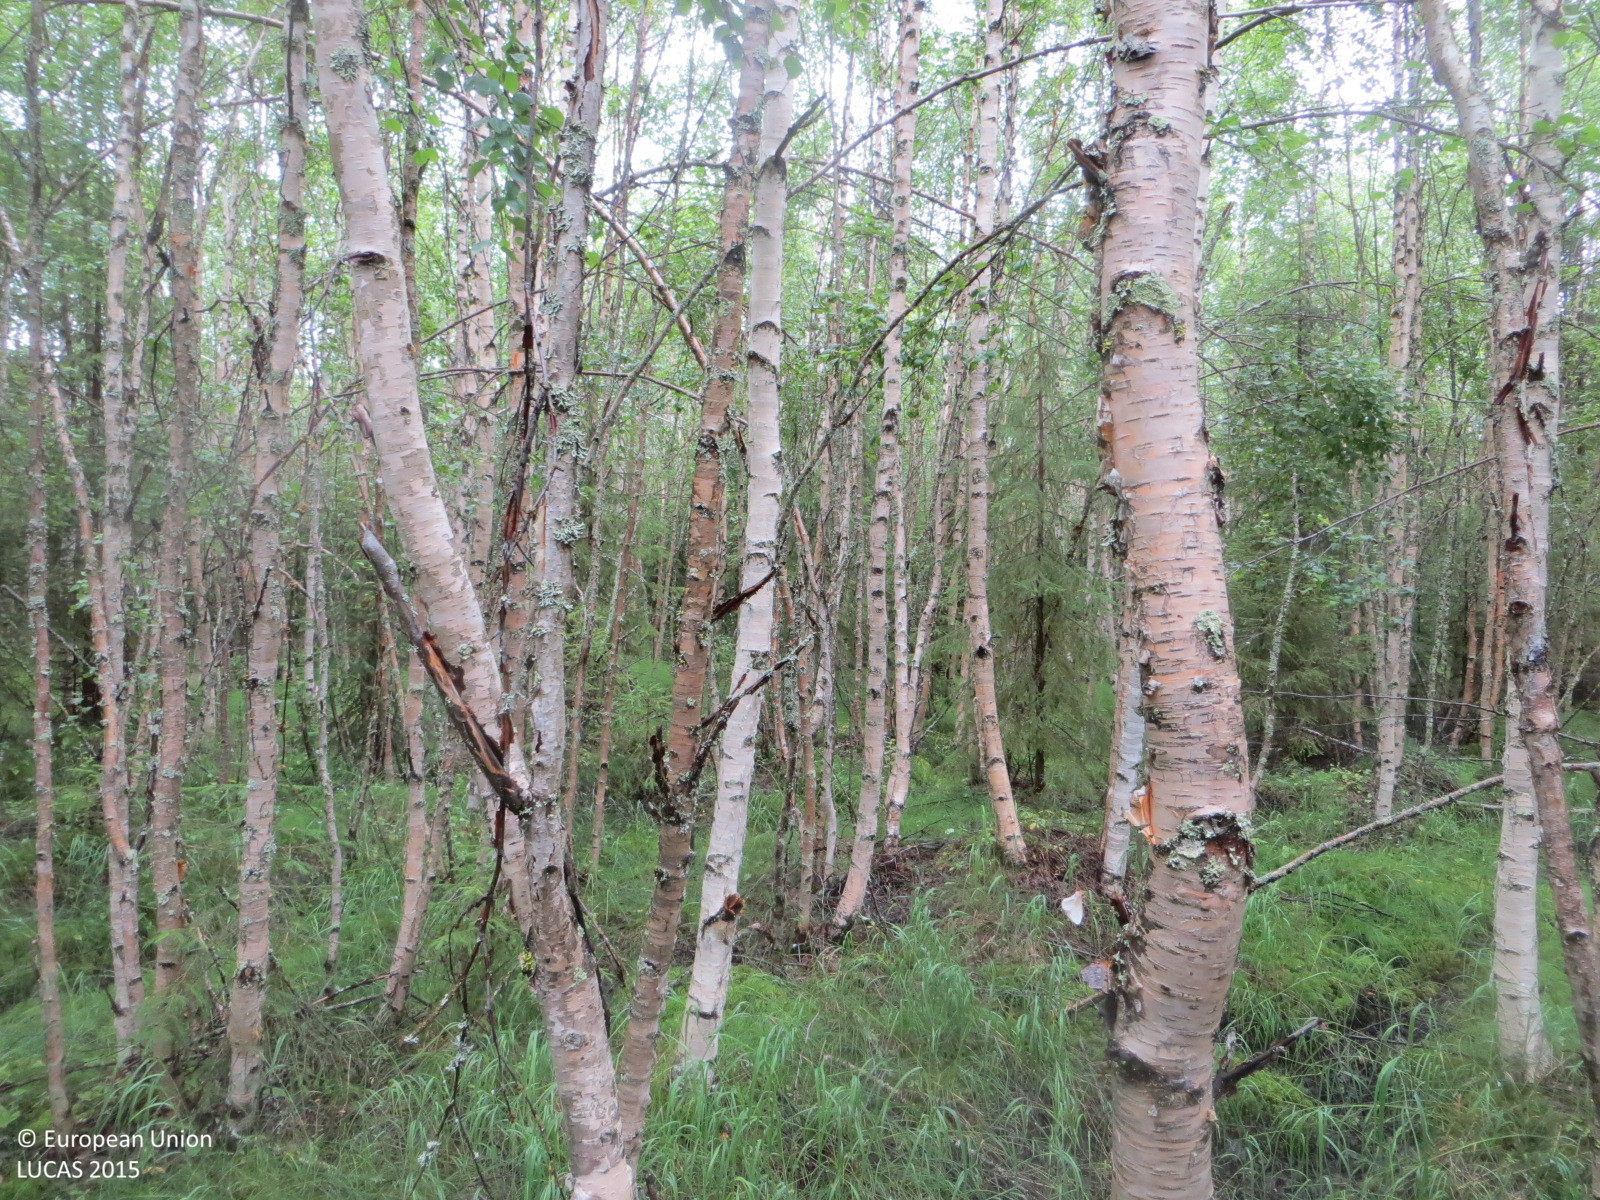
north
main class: Woodland
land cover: Spruce dominated mixed woodland
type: boreal forest
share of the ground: > 75 %
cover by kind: broadleaved forest trees 50 %, coniferous forest trees 30 %, shrubs 10 %, herbaceous plants 10 %
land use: Forestry
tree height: > 5 m
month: July
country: FI
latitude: 65.8462
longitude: 24.5305
